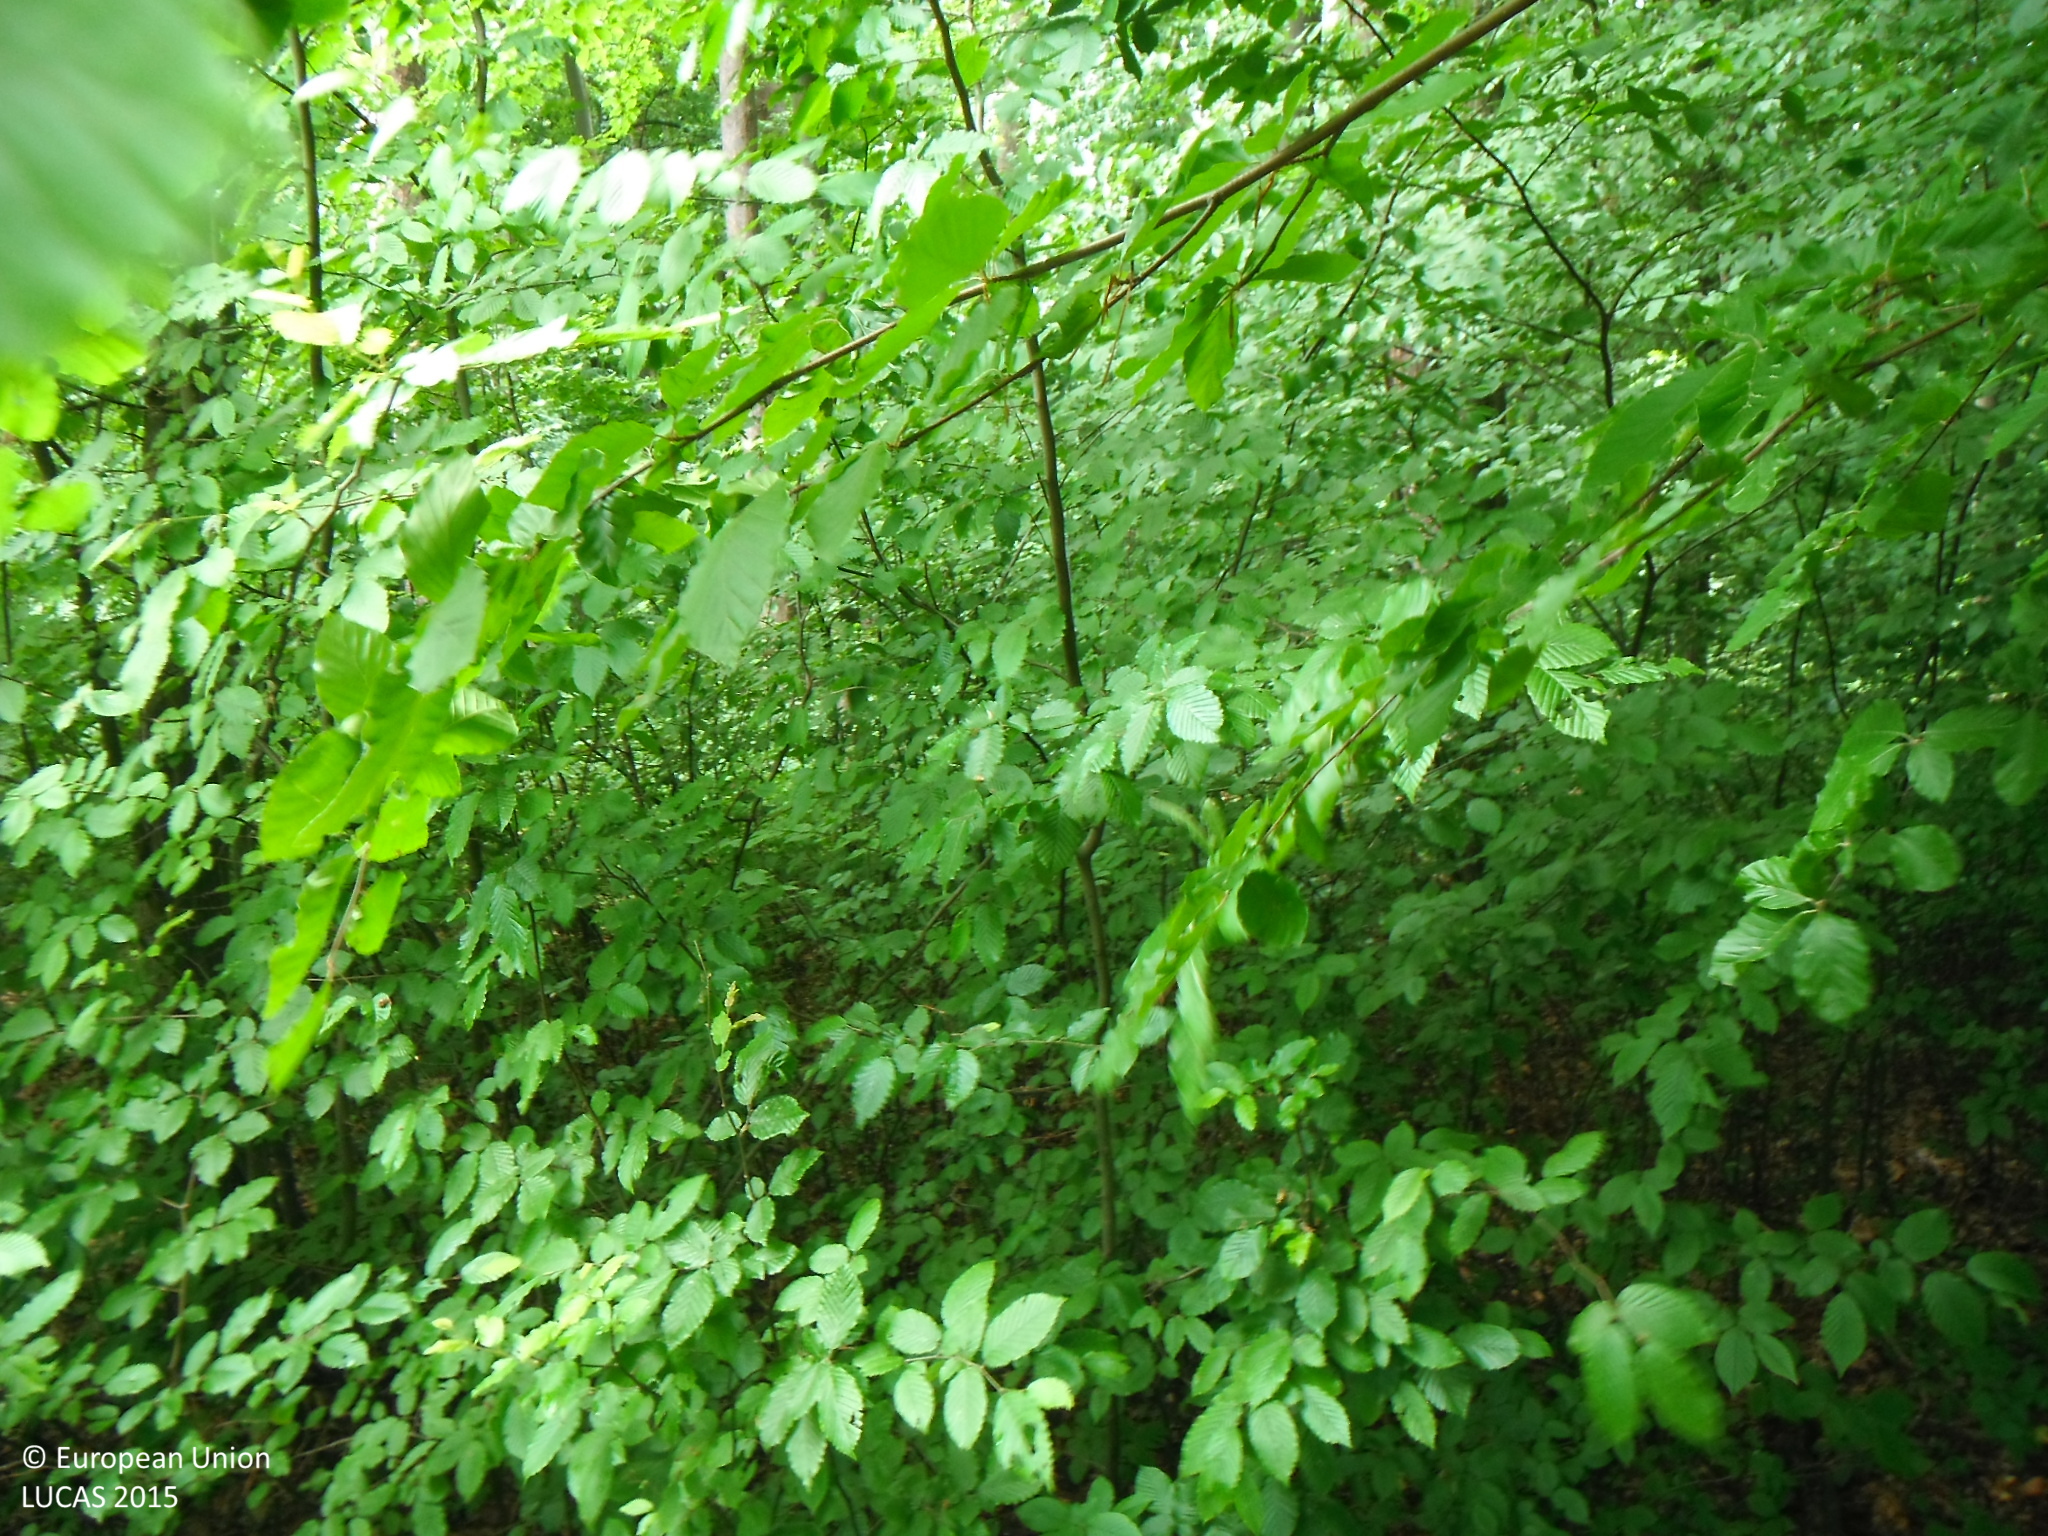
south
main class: Woodland
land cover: Broadleaved woodland
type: beech forest
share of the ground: > 75 %
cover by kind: broadleaved forest trees 75 %, shrubs 25 %
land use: Forestry
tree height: > 5 m
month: June
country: SK
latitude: 49.0919
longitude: 22.0109
